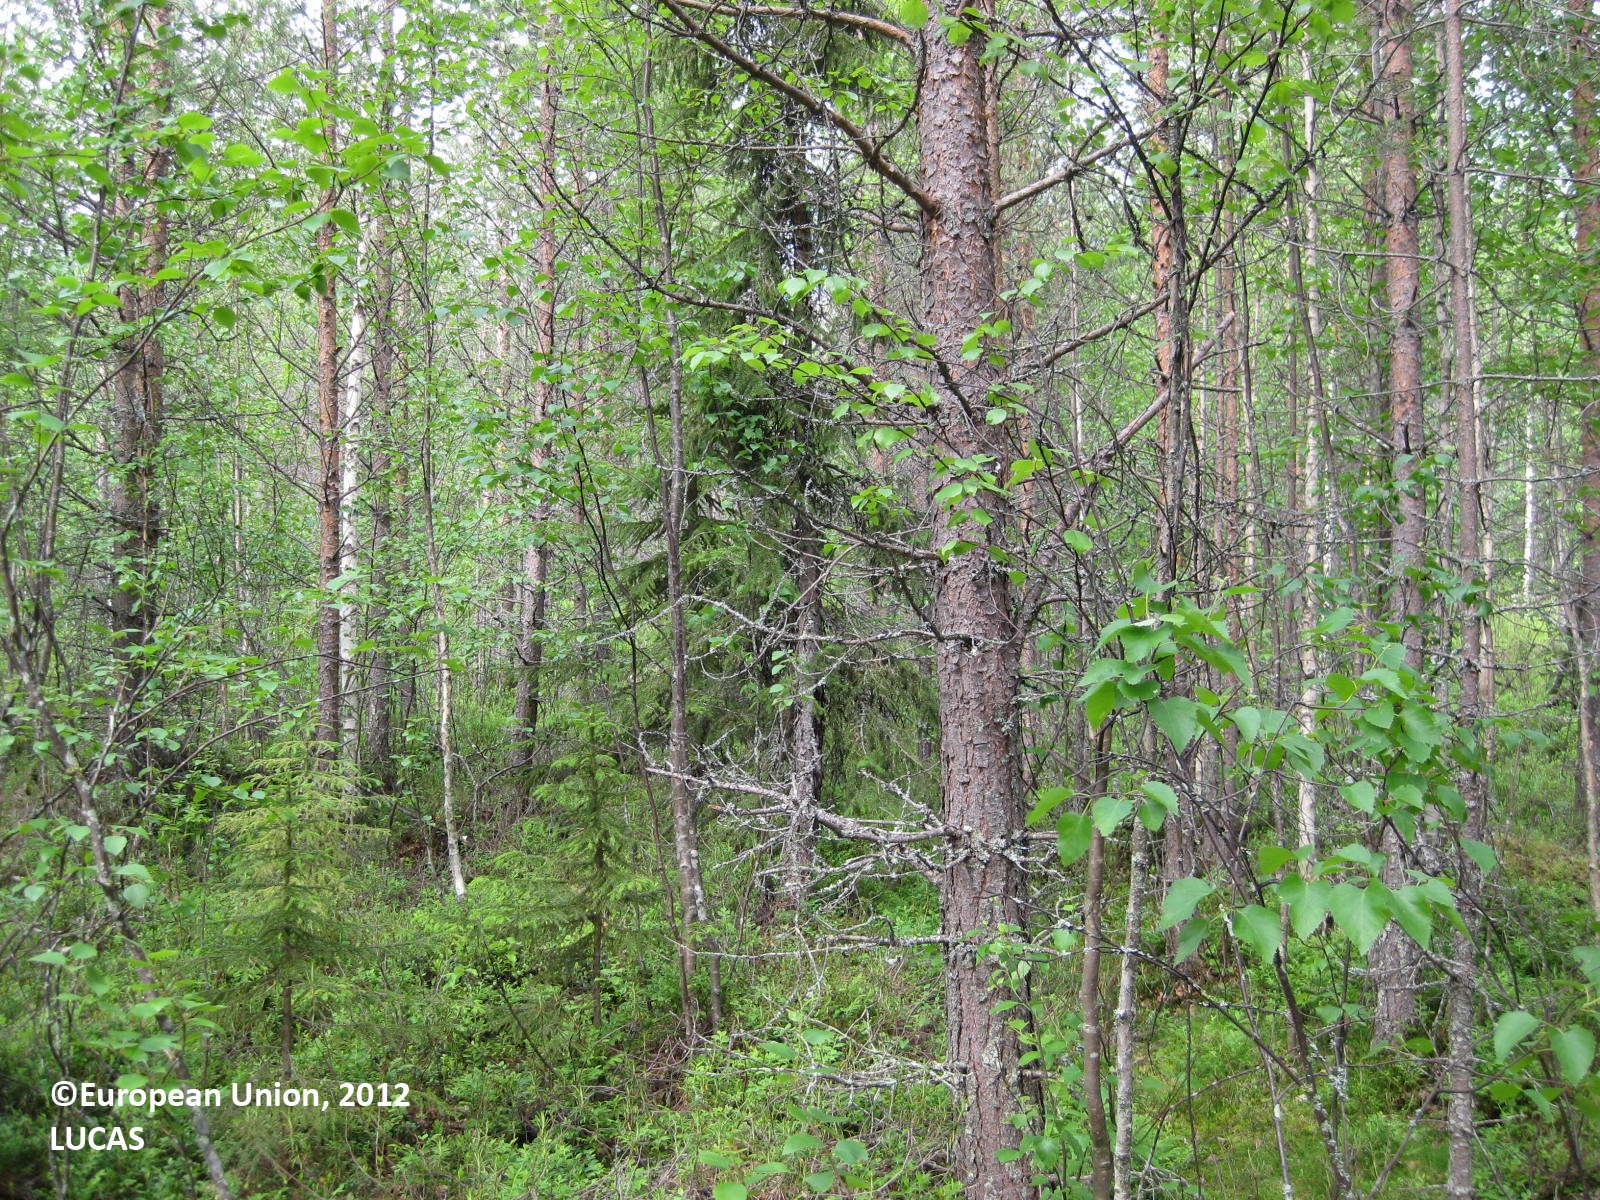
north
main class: Woodland
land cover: Pine dominated mixed woodland
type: boreal forest
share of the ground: > 75 %
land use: Forestry
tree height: > 5 m
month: June
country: FI
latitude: 65.3097
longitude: 28.1980
